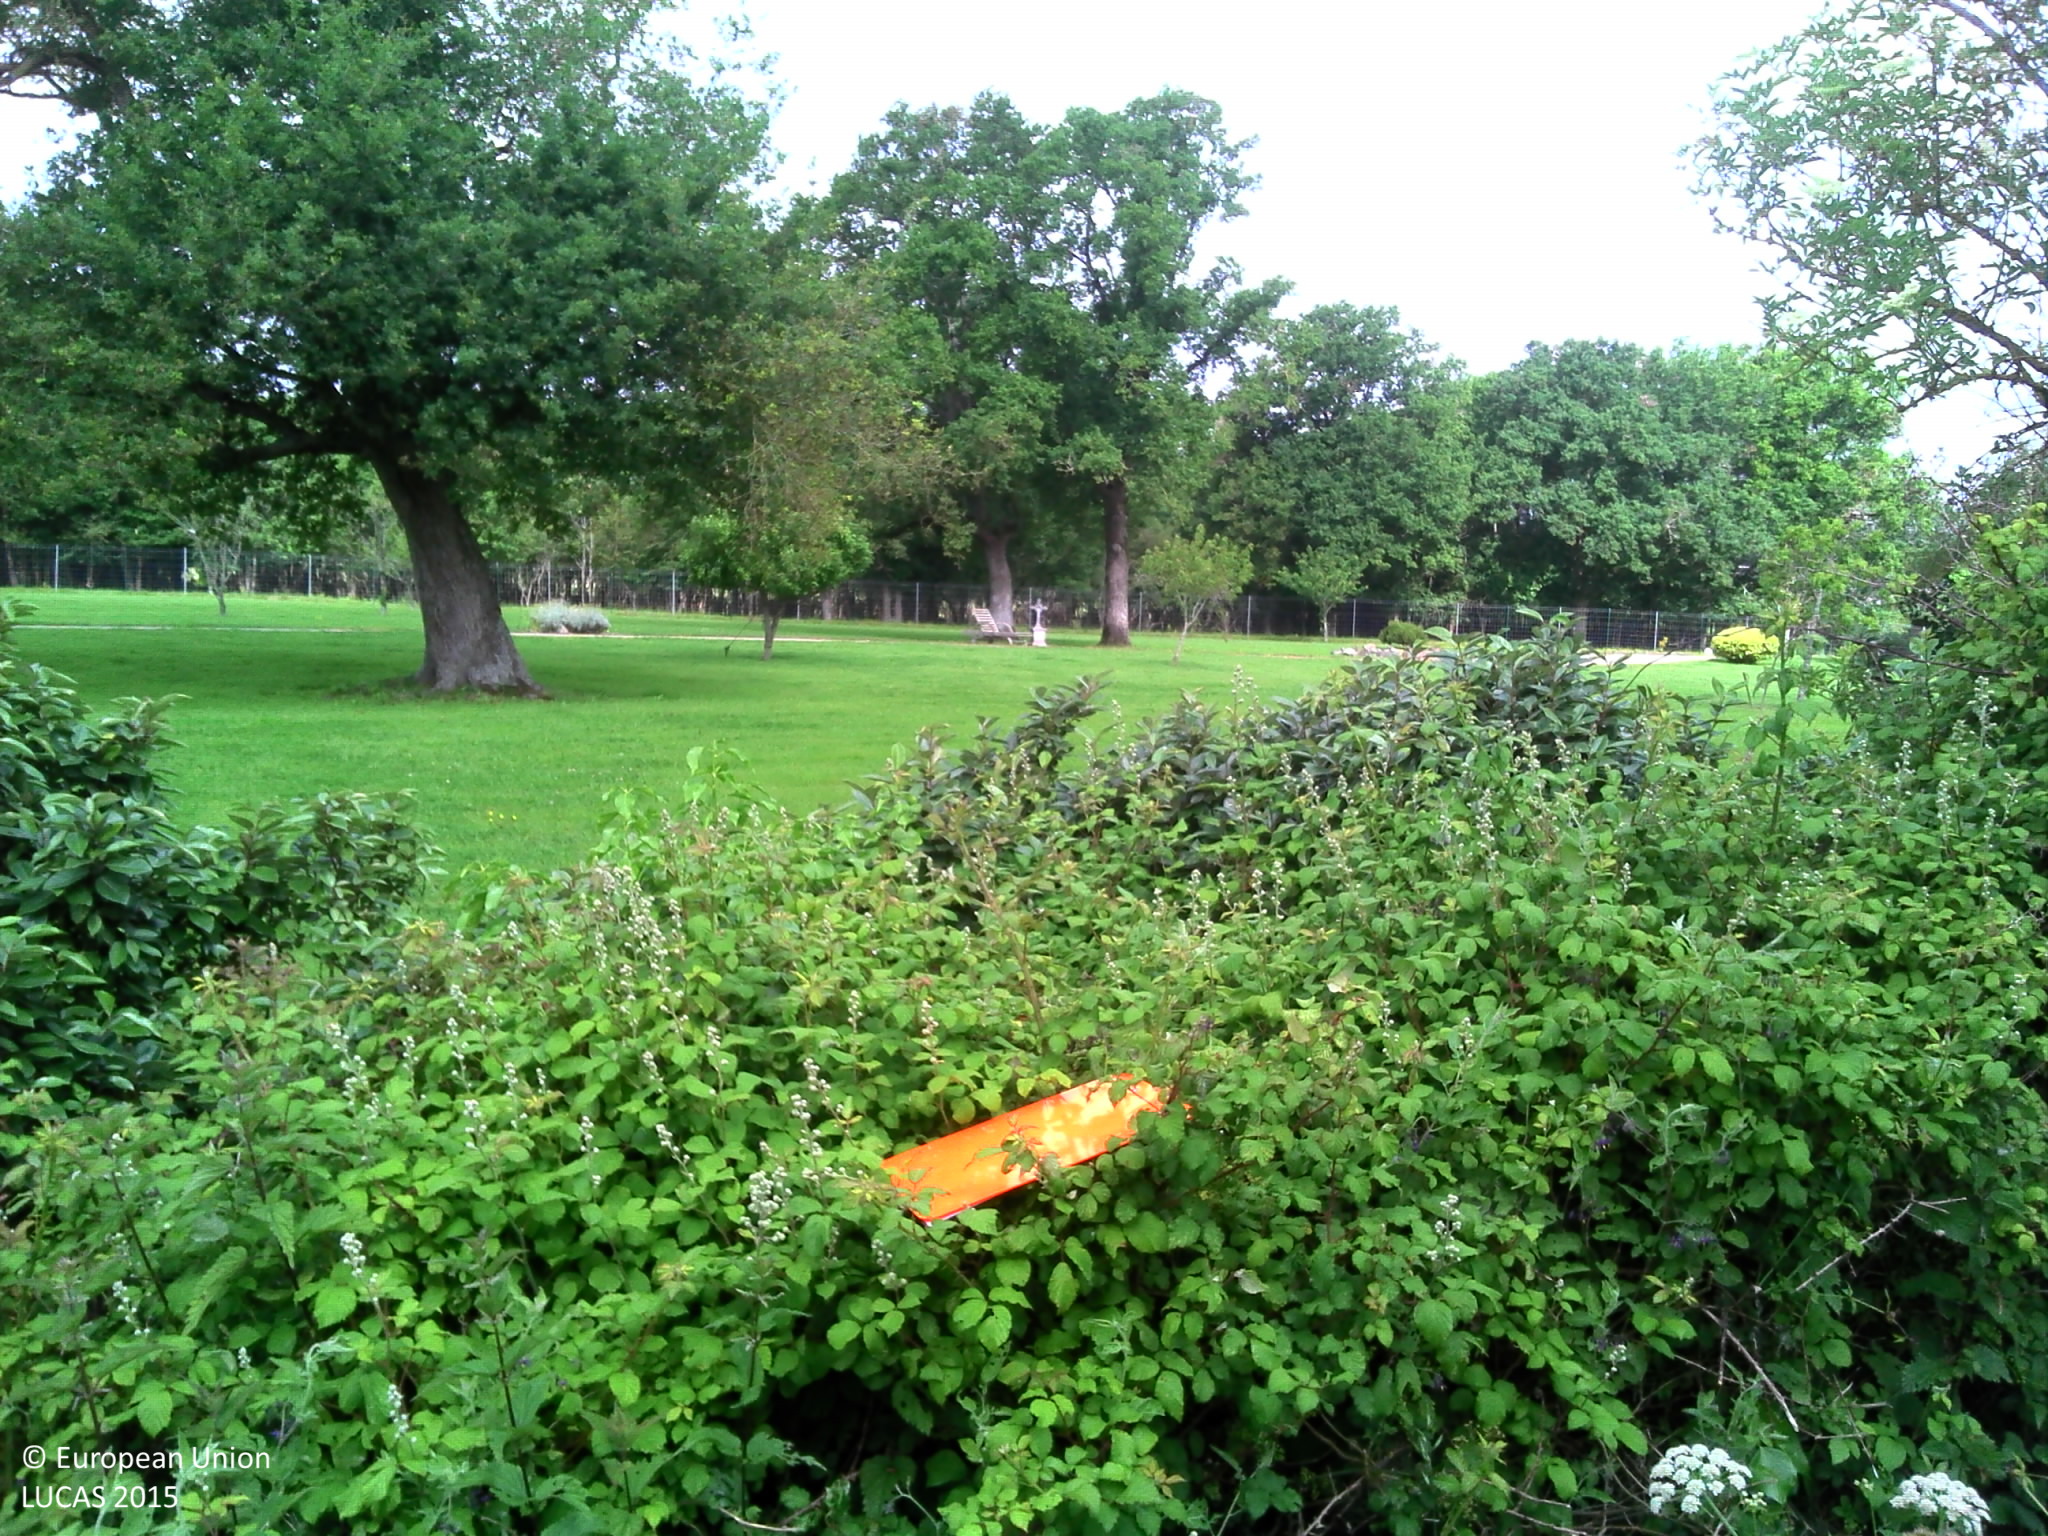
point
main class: Grassland
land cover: Grassland with sparse tree/shrub cover
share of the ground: > 75 %
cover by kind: herbaceous plants 90 %, broadleaved forest trees 5 %, shrubs 5 %
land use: Residential
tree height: < 5 m
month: June
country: FR
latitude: 46.9269
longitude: -1.8514
